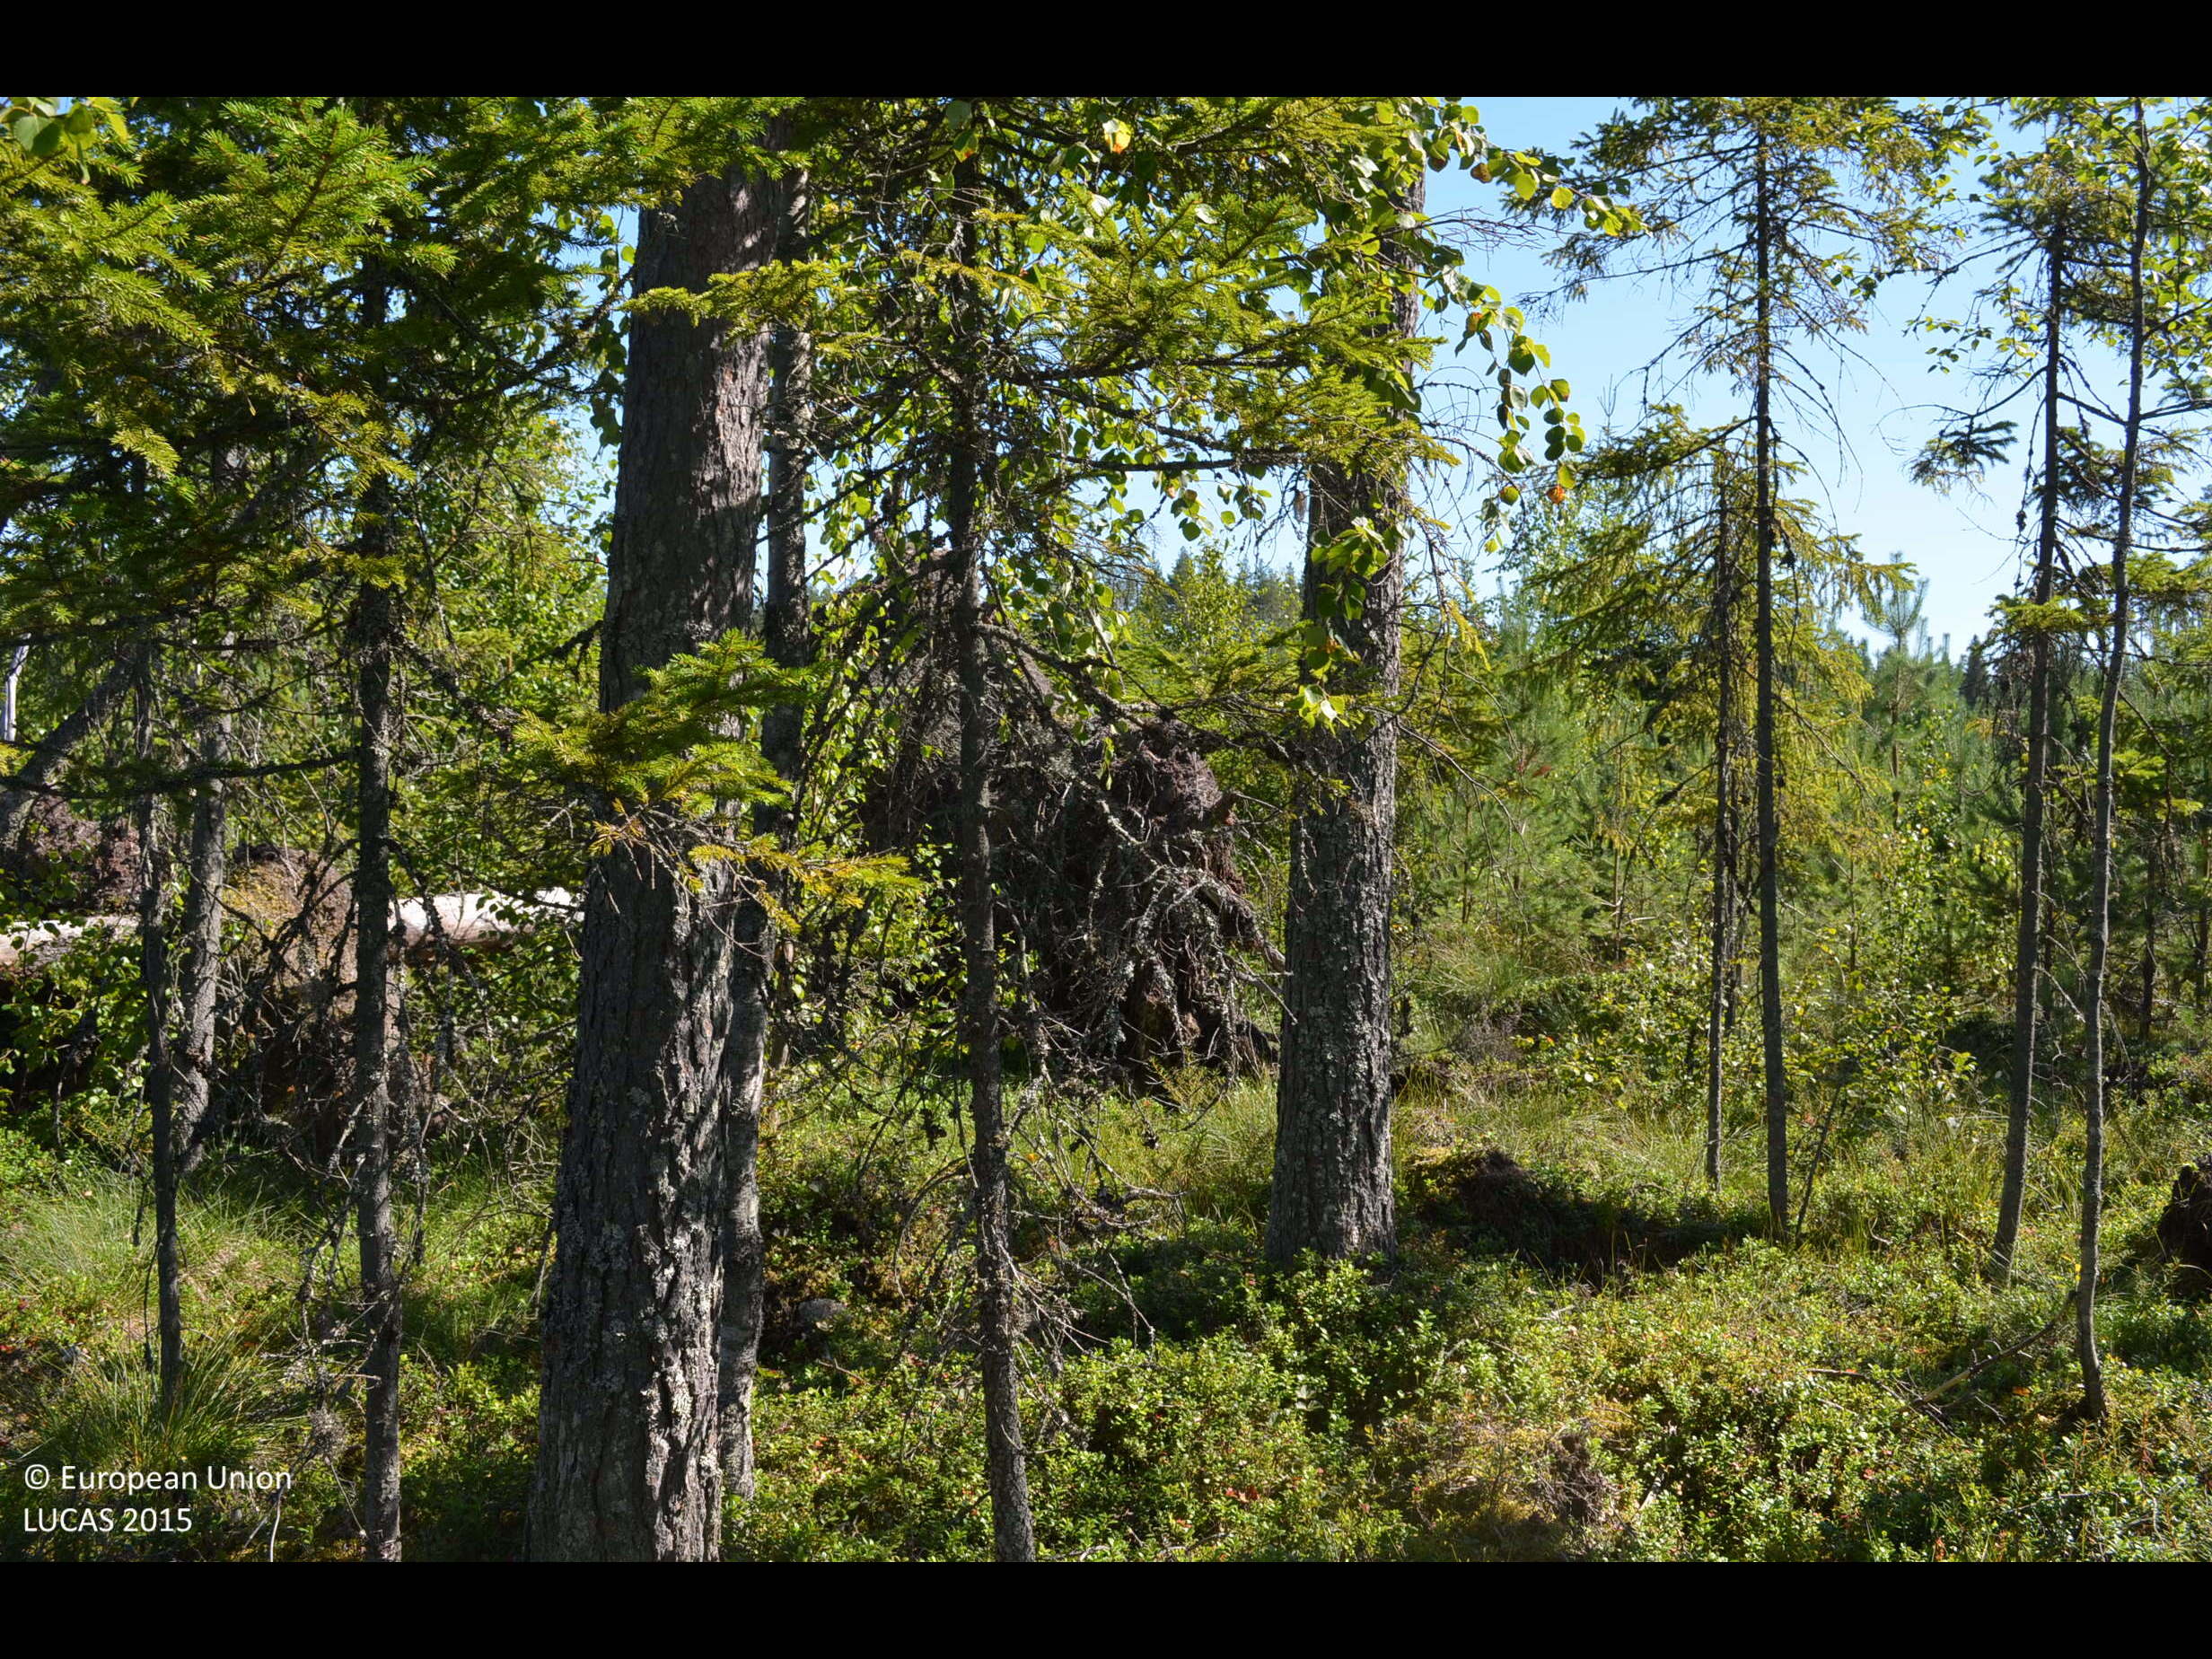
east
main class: Woodland
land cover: Other mixed woodland
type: boreal forest
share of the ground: 50 - 75 %
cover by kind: coniferous forest trees 50 %, shrubs 25 %, broadleaved forest trees 20 %, herbaceous plants 5 %
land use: Forestry
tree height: < 5 m
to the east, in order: Other mixed woodland; Ditches and canals; Other mixed woodland; Ditches and canals; Other mixed woodland; Ditches and canals; Other mixed woodland; Ditches and canals; Other mixed woodland; Ditches and canals; Other mixed woodland; Ditches and canals; Other mixed woodland; Ditches and canals; Other mixed woodland; Ditches and canals; Other mixed woodland
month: August
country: FI
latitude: 62.1486
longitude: 24.2676
